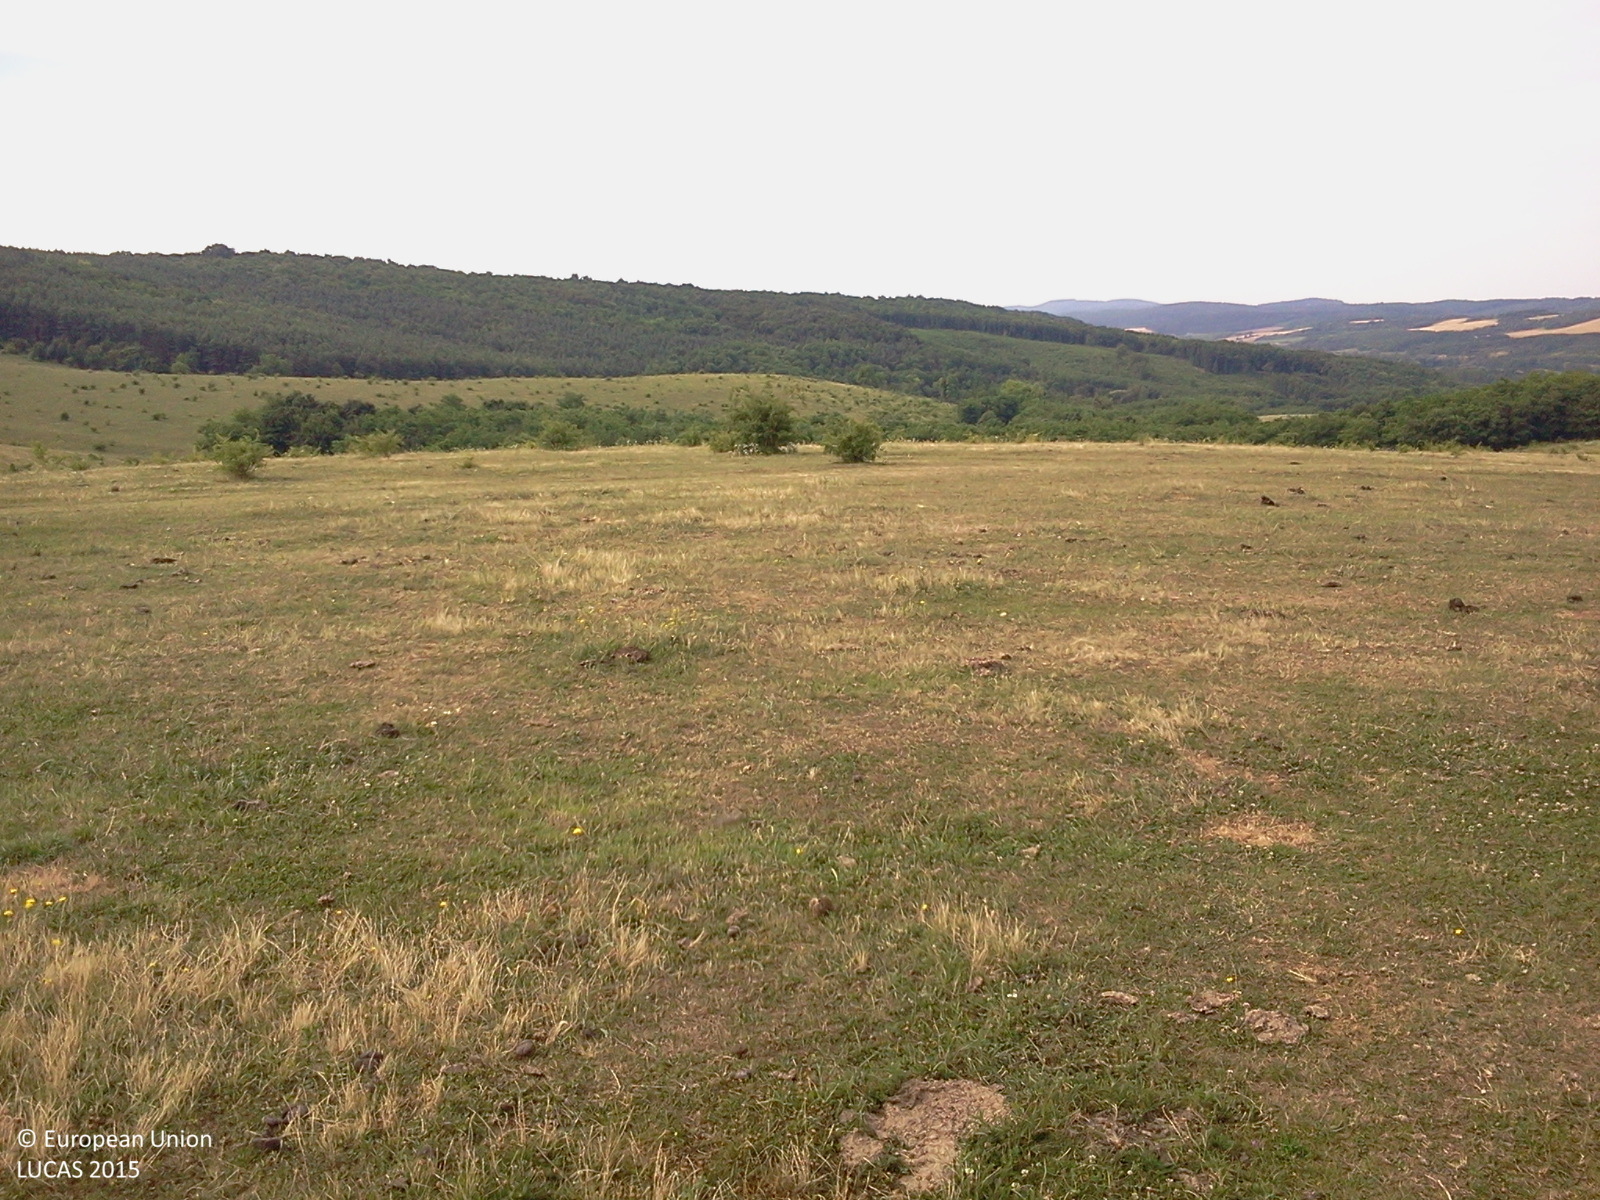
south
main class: Grassland
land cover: Grassland without tree/shrub cover
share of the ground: > 75 %
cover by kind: herbaceous plants 100 %
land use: Agriculture (excluding fallow land and kitchen gardens)
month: June
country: HU
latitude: 46.8989
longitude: 17.0004
